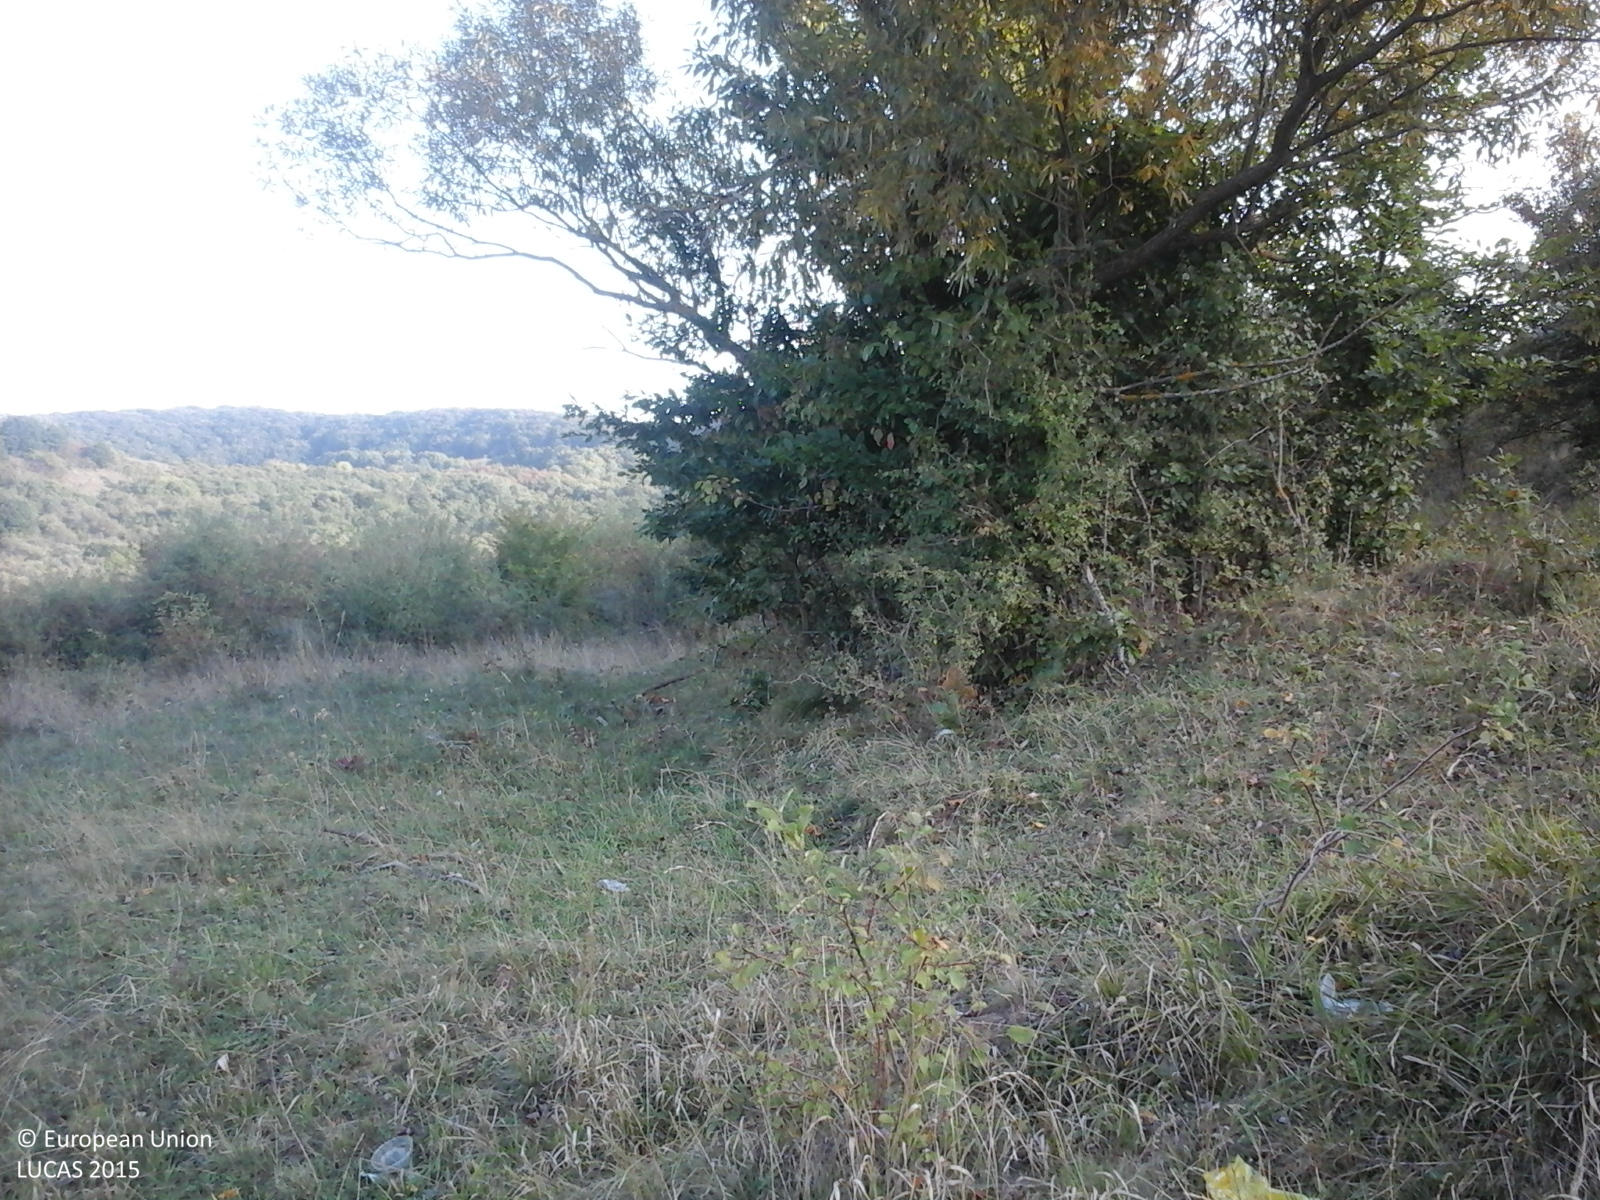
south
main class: Grassland
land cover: Grassland with sparse tree/shrub cover
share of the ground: > 75 %
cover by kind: herbaceous plants 95 %, broadleaved forest trees 5 %
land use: Fallow land
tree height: < 5 m
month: September
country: RO
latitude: 46.9975
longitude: 23.4171
